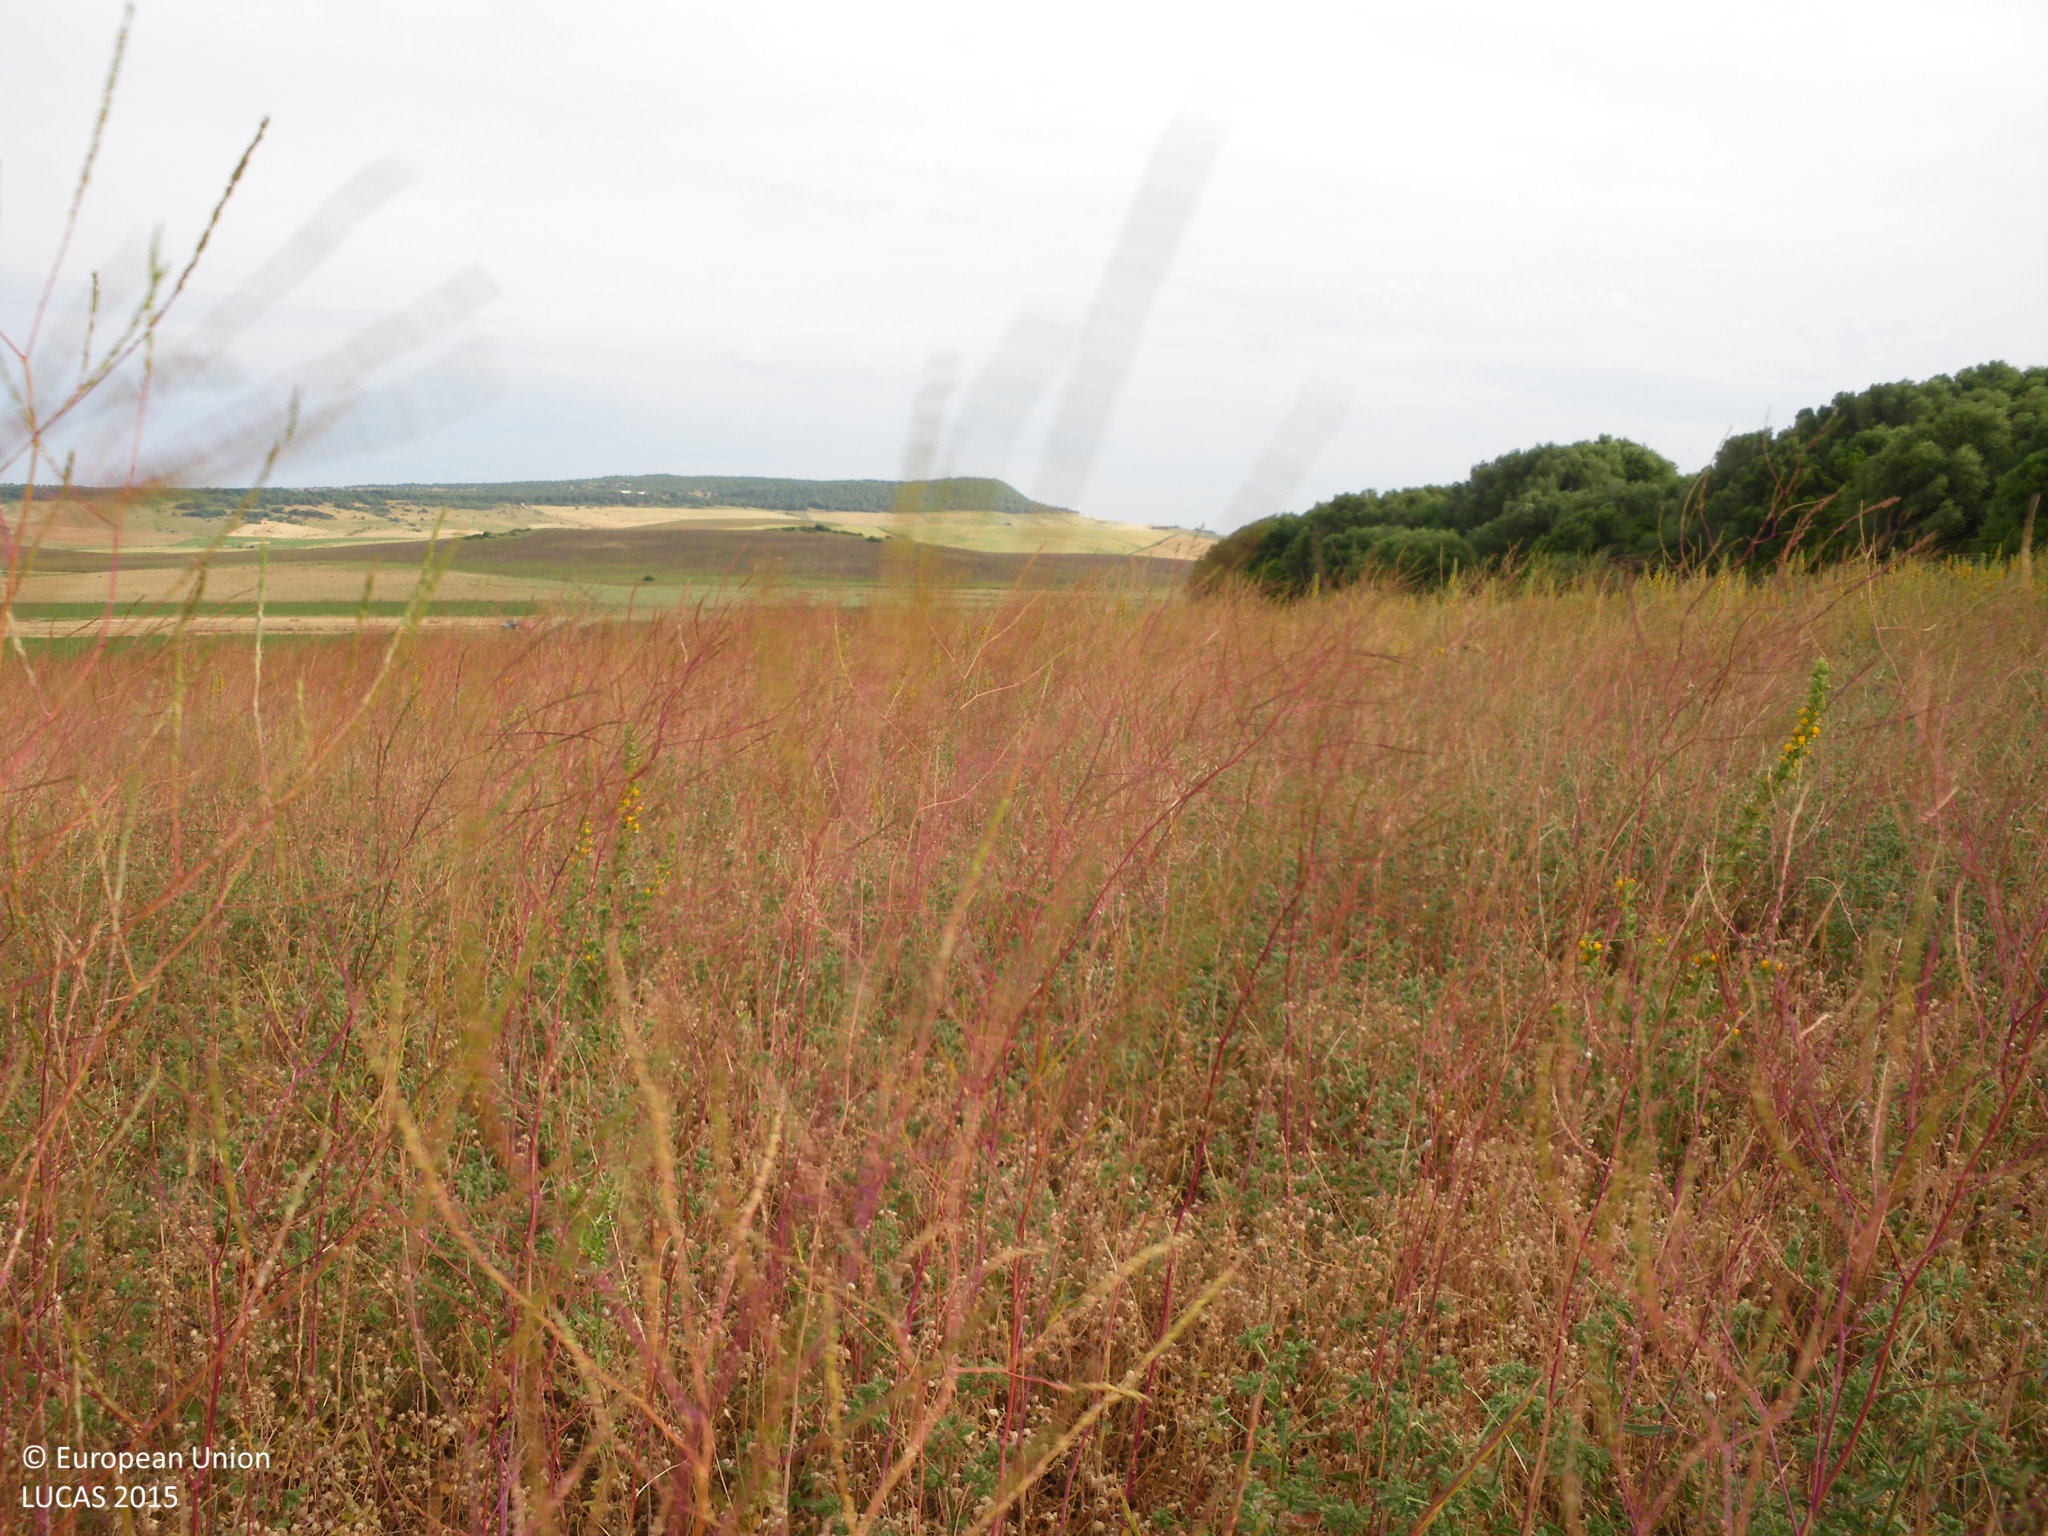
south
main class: Grassland
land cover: Spontaneously vegetated surfaces
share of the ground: > 75 %
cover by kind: herbaceous plants 95 %, unconsolidated bare surface 5 %
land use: Agriculture (excluding fallow land and kitchen gardens)
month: May
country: ES
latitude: 36.3981
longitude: -5.9137
